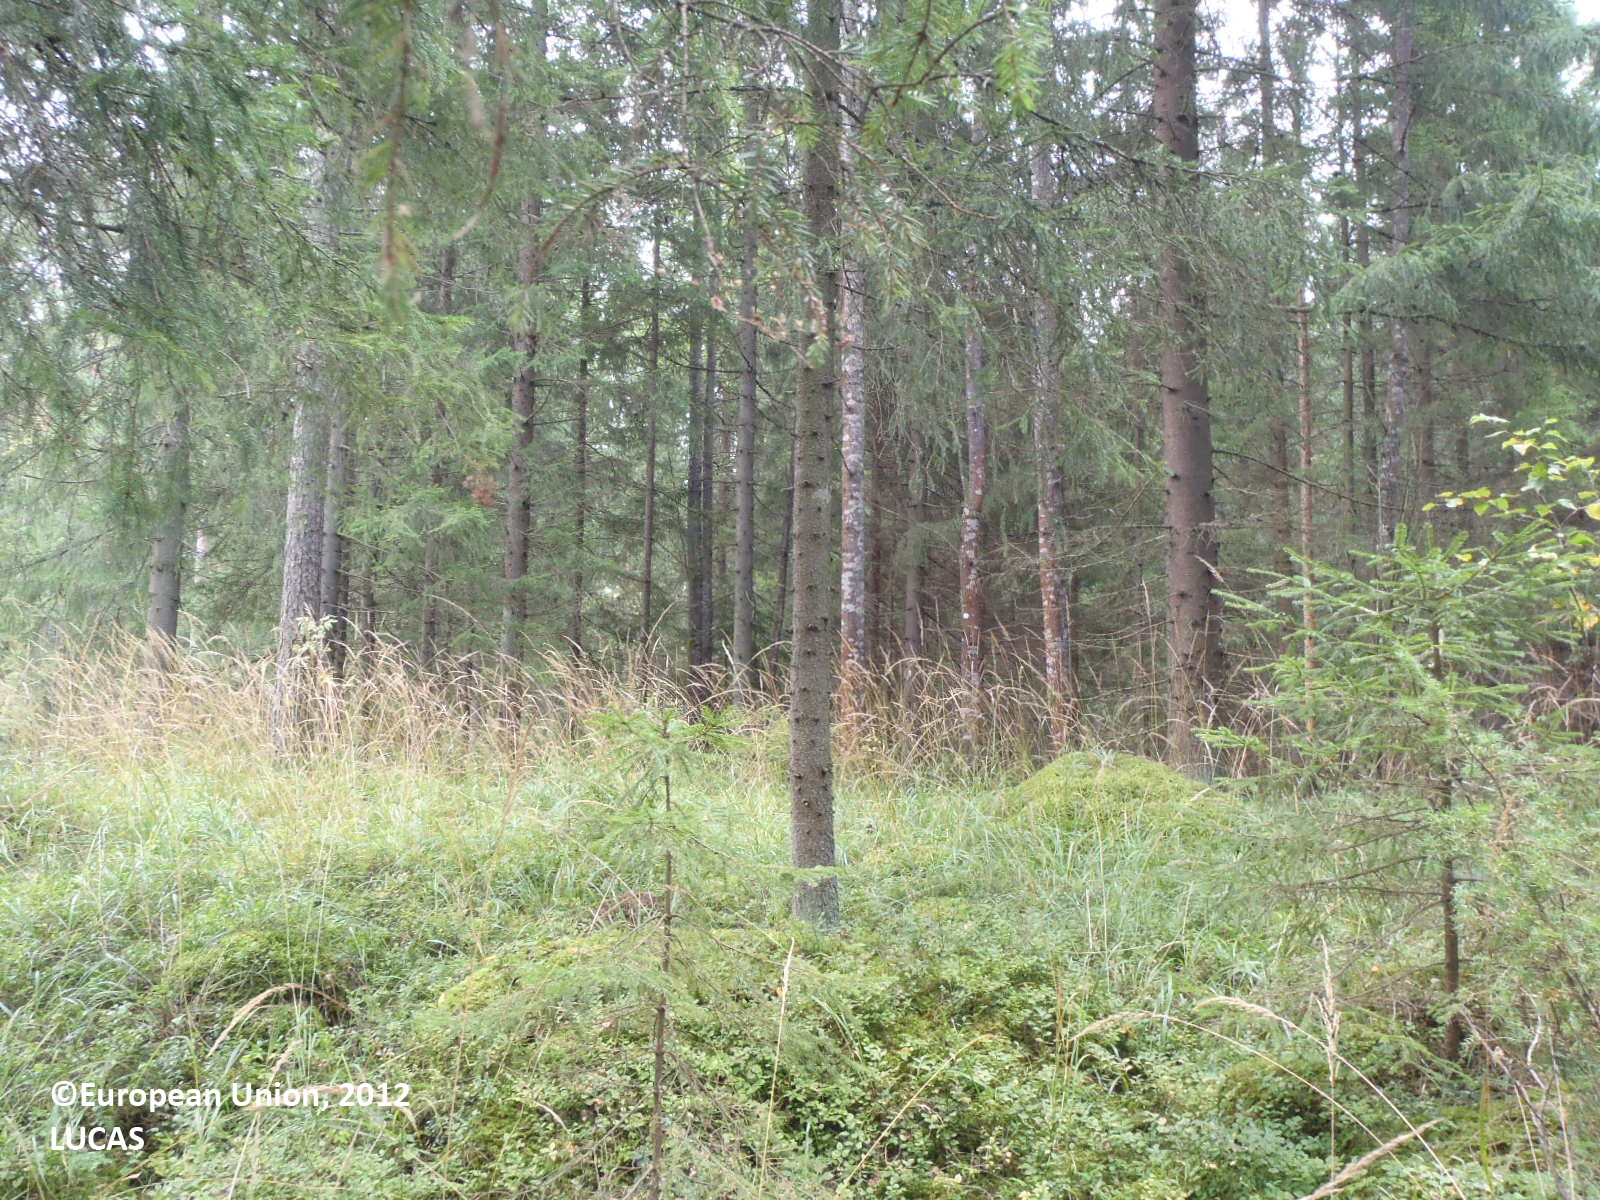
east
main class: Woodland
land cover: Spruce dominated coniferous woodland
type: boreal forest
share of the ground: > 75 %
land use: Forestry
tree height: > 5 m
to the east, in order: Spruce dominated coniferous woodland; Paved roads, cycling and walking lanes; Grass margins; Ditches and canals; Grass margins; Barley
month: August
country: FI
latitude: 60.8498
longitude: 22.4532
